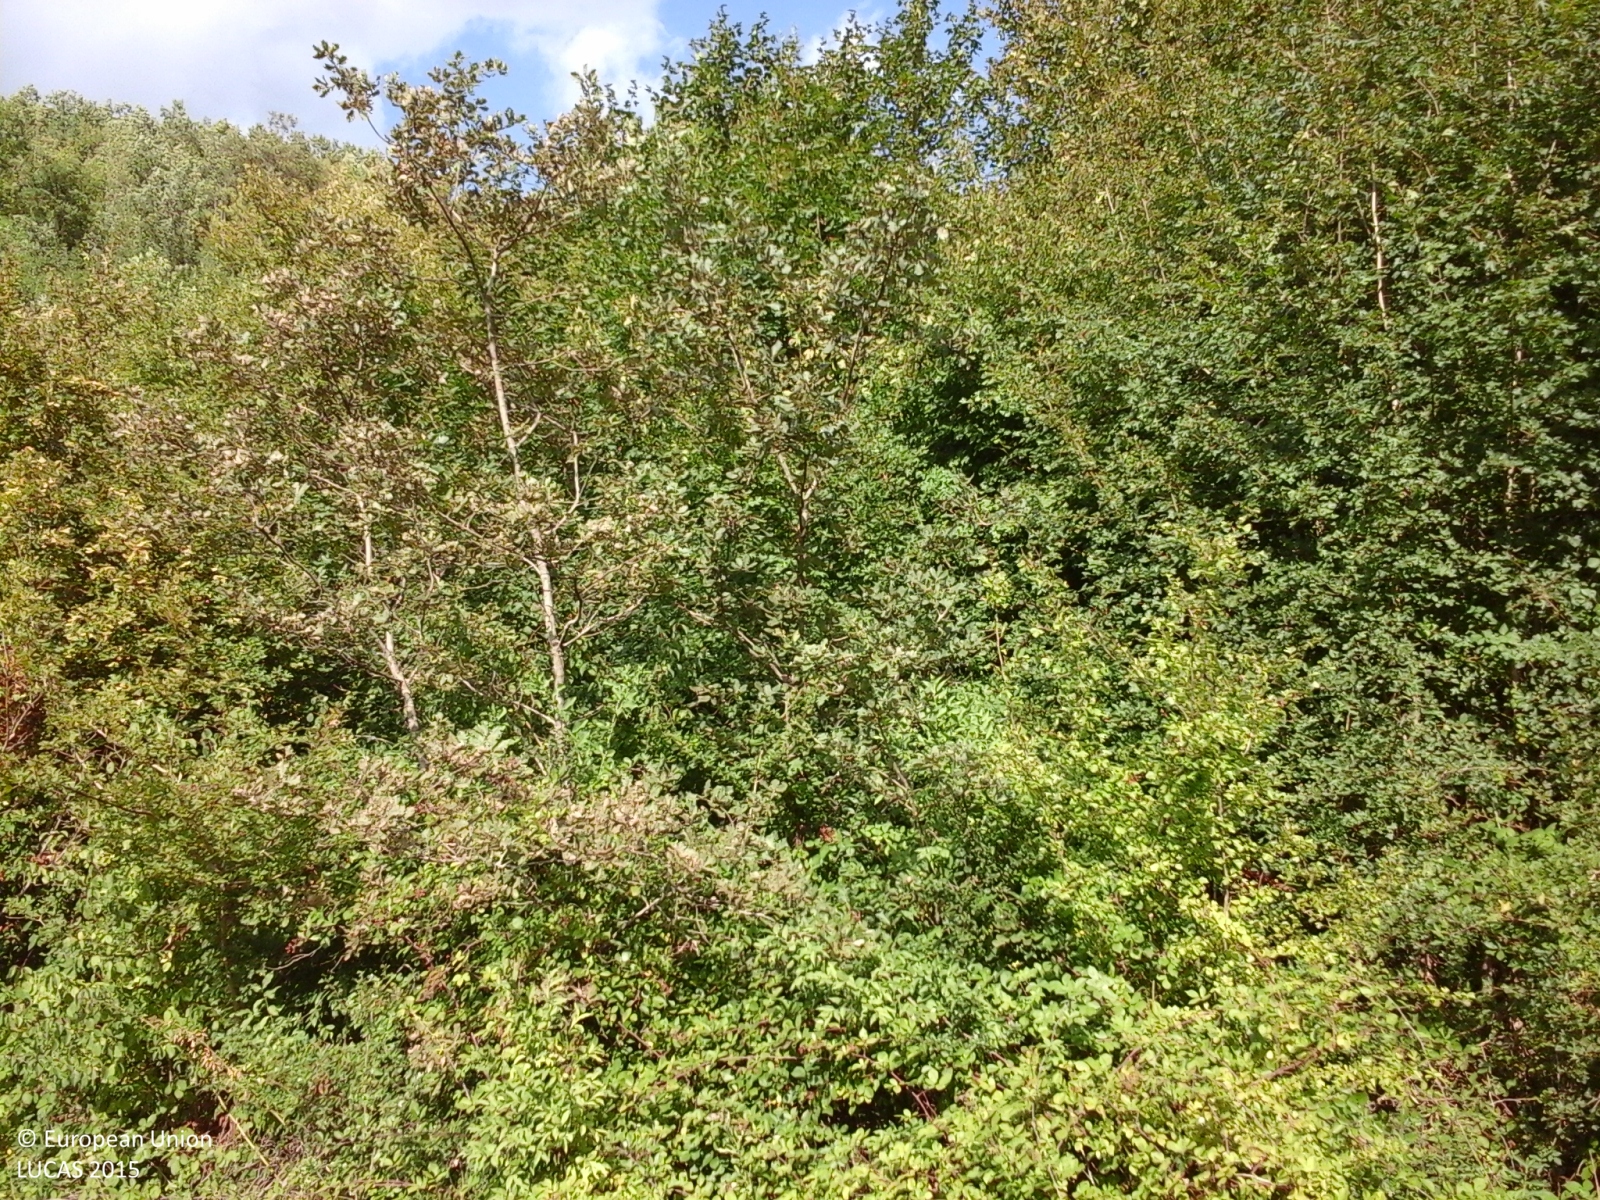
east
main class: Woodland
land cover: Broadleaved woodland
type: thermophilous deciduous forest
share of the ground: > 75 %
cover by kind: broadleaved forest trees 85 %, shrubs 10 %, herbaceous plants 5 %
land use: Semi-natural and natural areas not in use
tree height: > 5 m
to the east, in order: Broadleaved woodland; Tracks; Broadleaved woodland
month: August
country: IT
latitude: 41.5681
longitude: 14.2897
